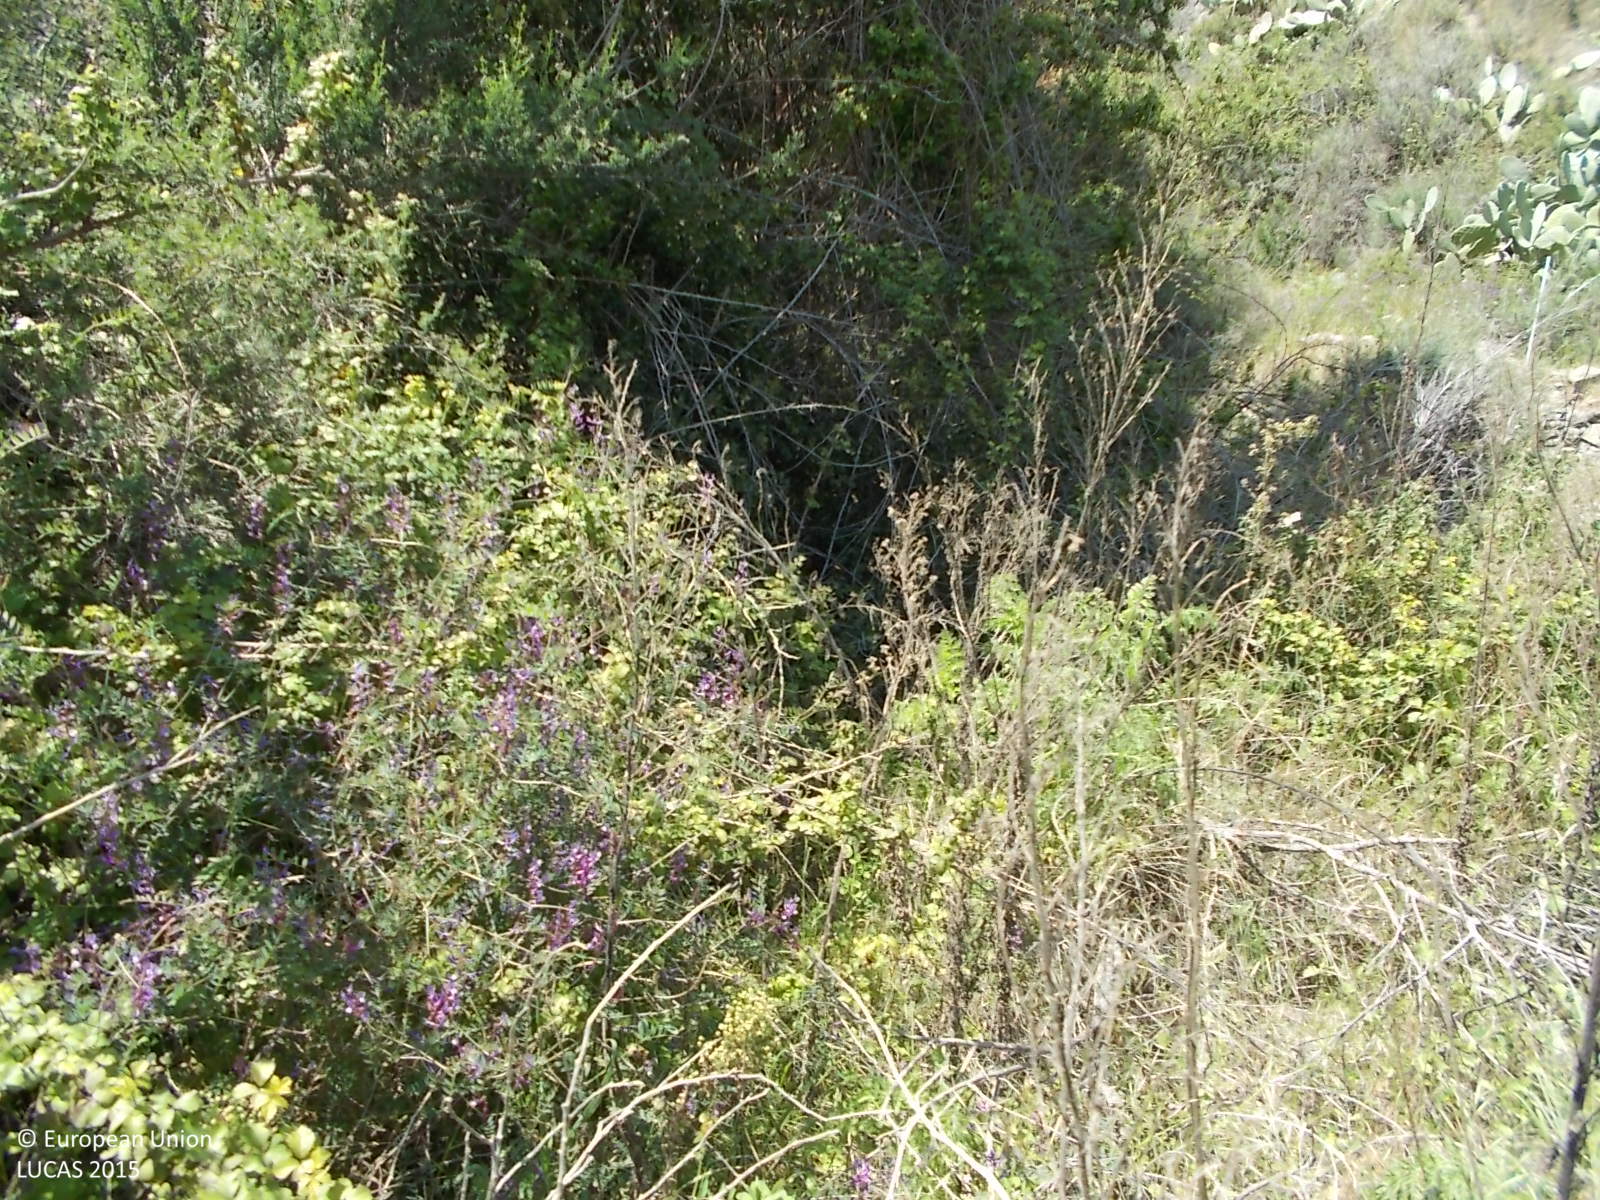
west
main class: Cropland
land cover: Other citrus fruit
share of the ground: 10 - 25 %
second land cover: Spontaneously vegetated surfaces
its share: > 75 %
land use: Abandoned areas
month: April
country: CY
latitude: 34.8248
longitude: 33.0994
